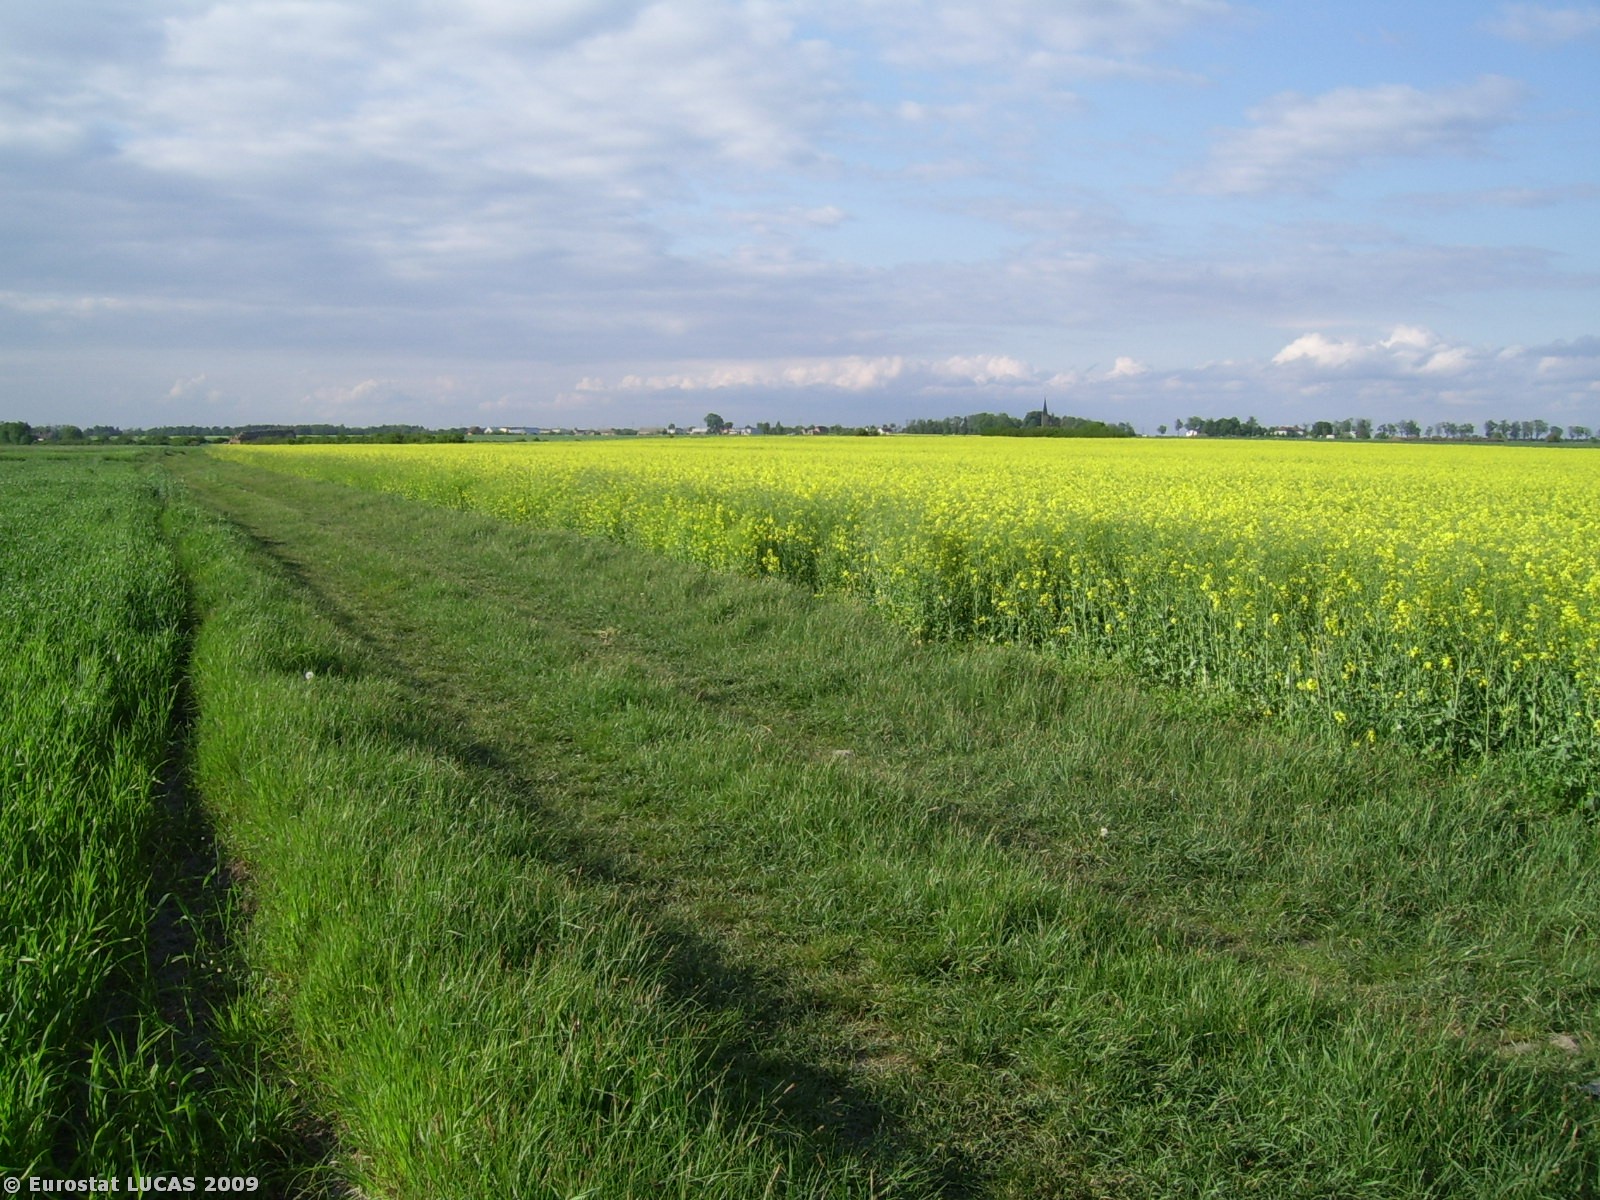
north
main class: Cropland
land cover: Triticale
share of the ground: > 75 %
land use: Agriculture (excluding fallow land and kitchen gardens)
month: May
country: PL
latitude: 51.8890
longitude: 16.8821
